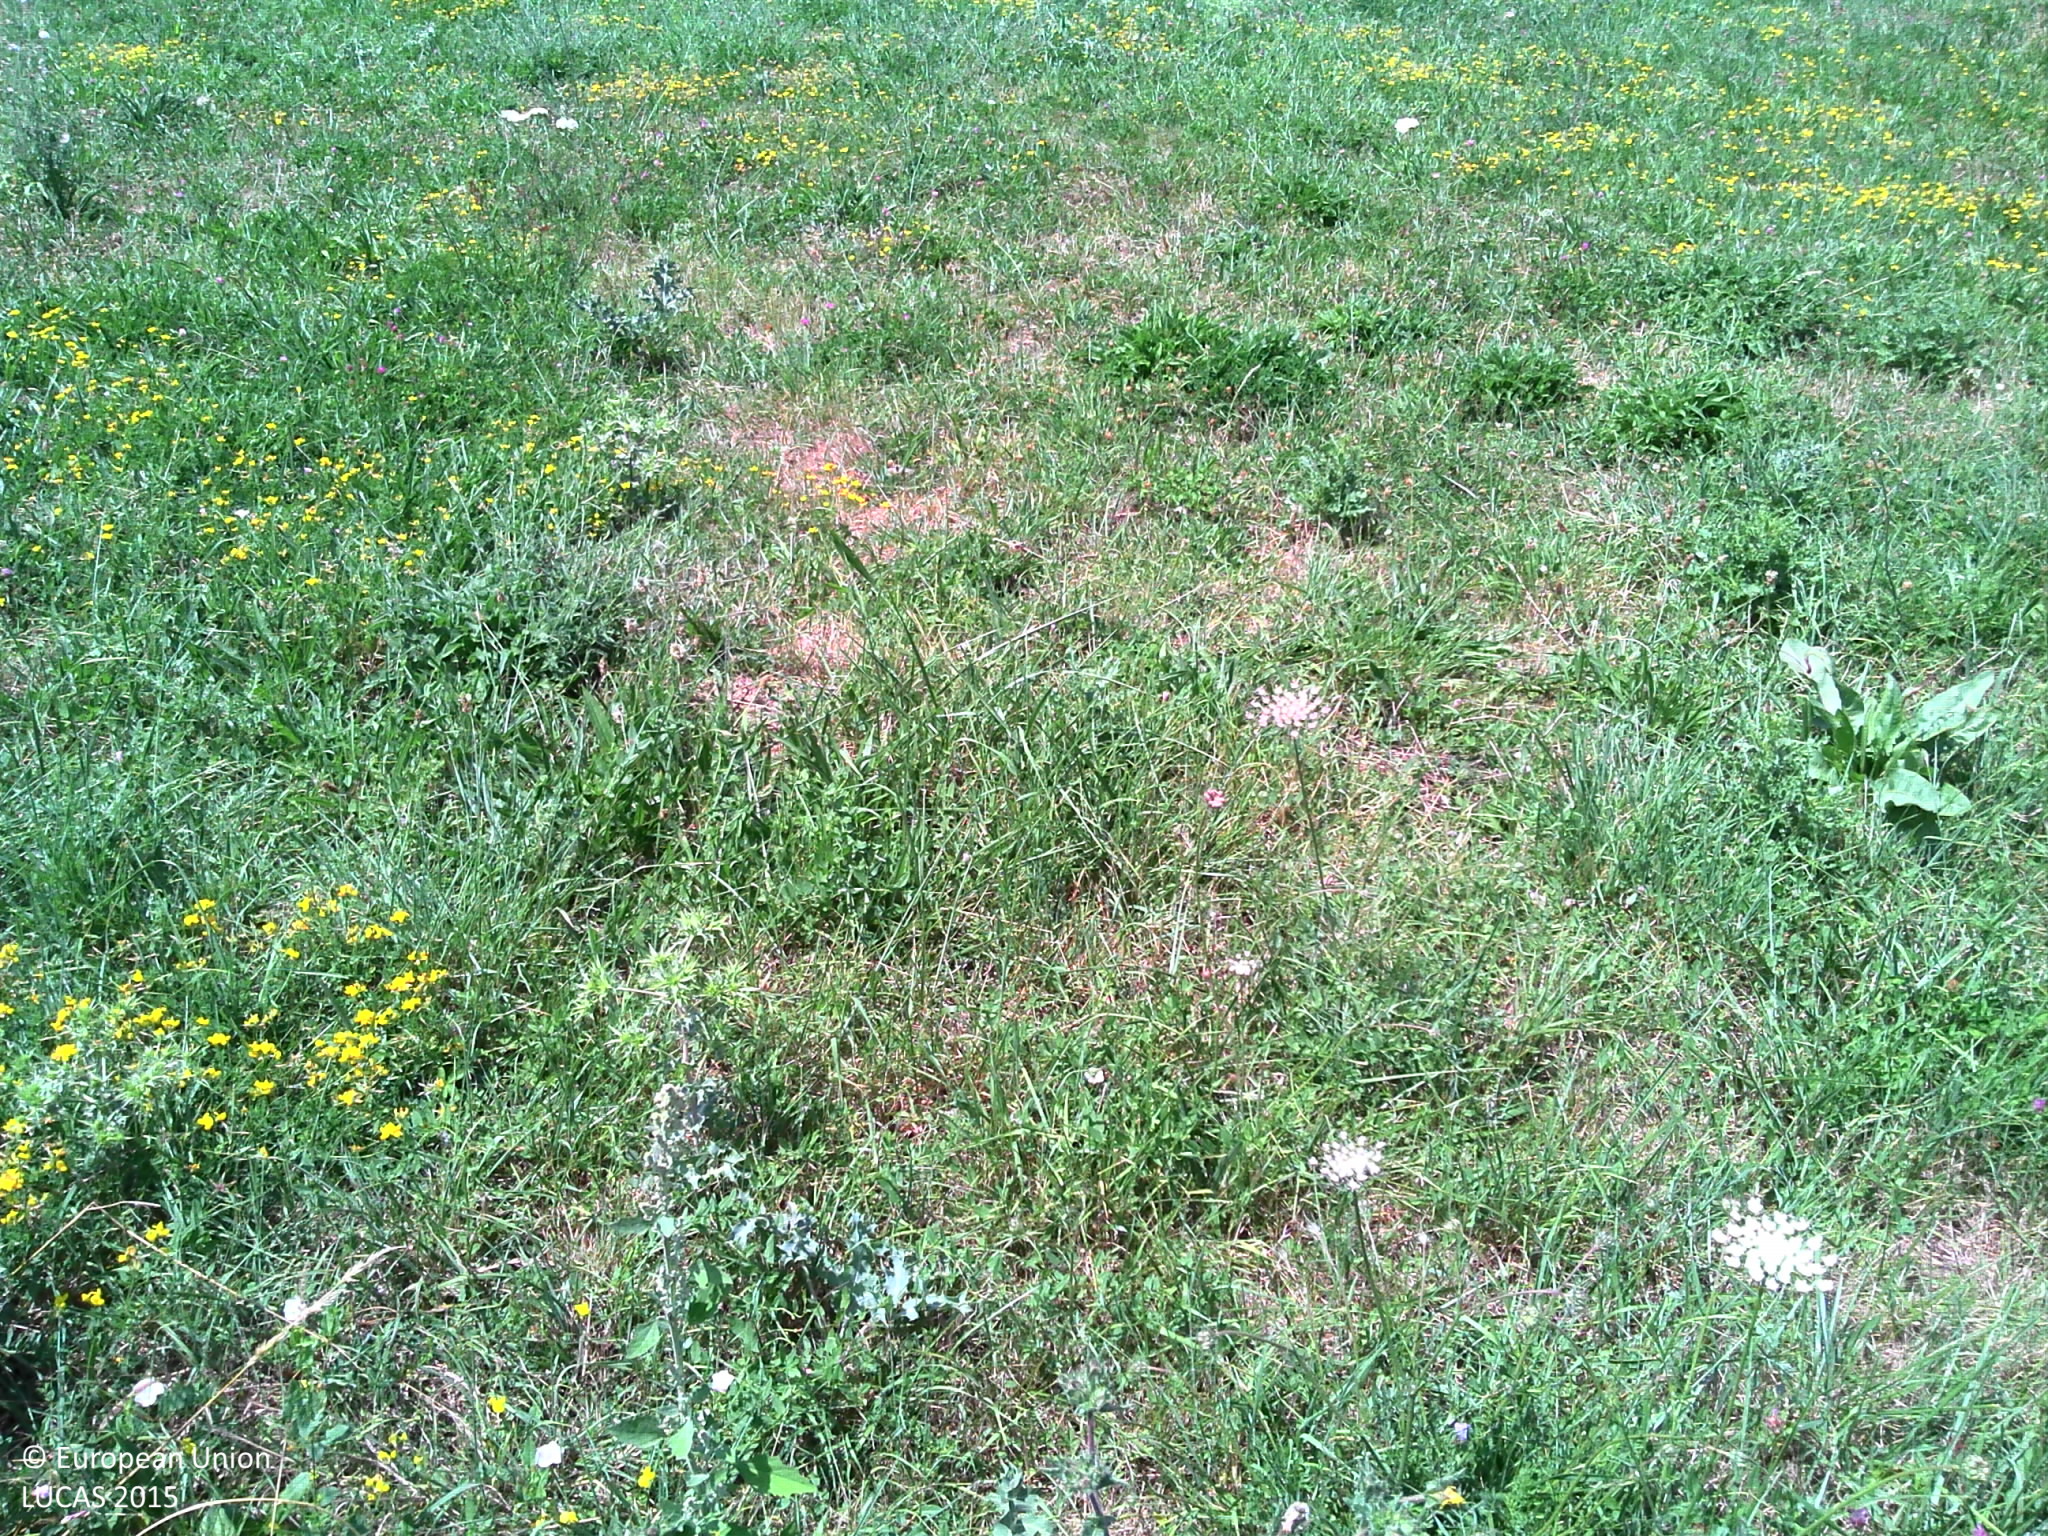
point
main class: Grassland
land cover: Grassland without tree/shrub cover
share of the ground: > 75 %
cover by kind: herbaceous plants 100 %
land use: Agriculture (excluding fallow land and kitchen gardens)
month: July
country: FR
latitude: 43.6318
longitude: 1.6370
